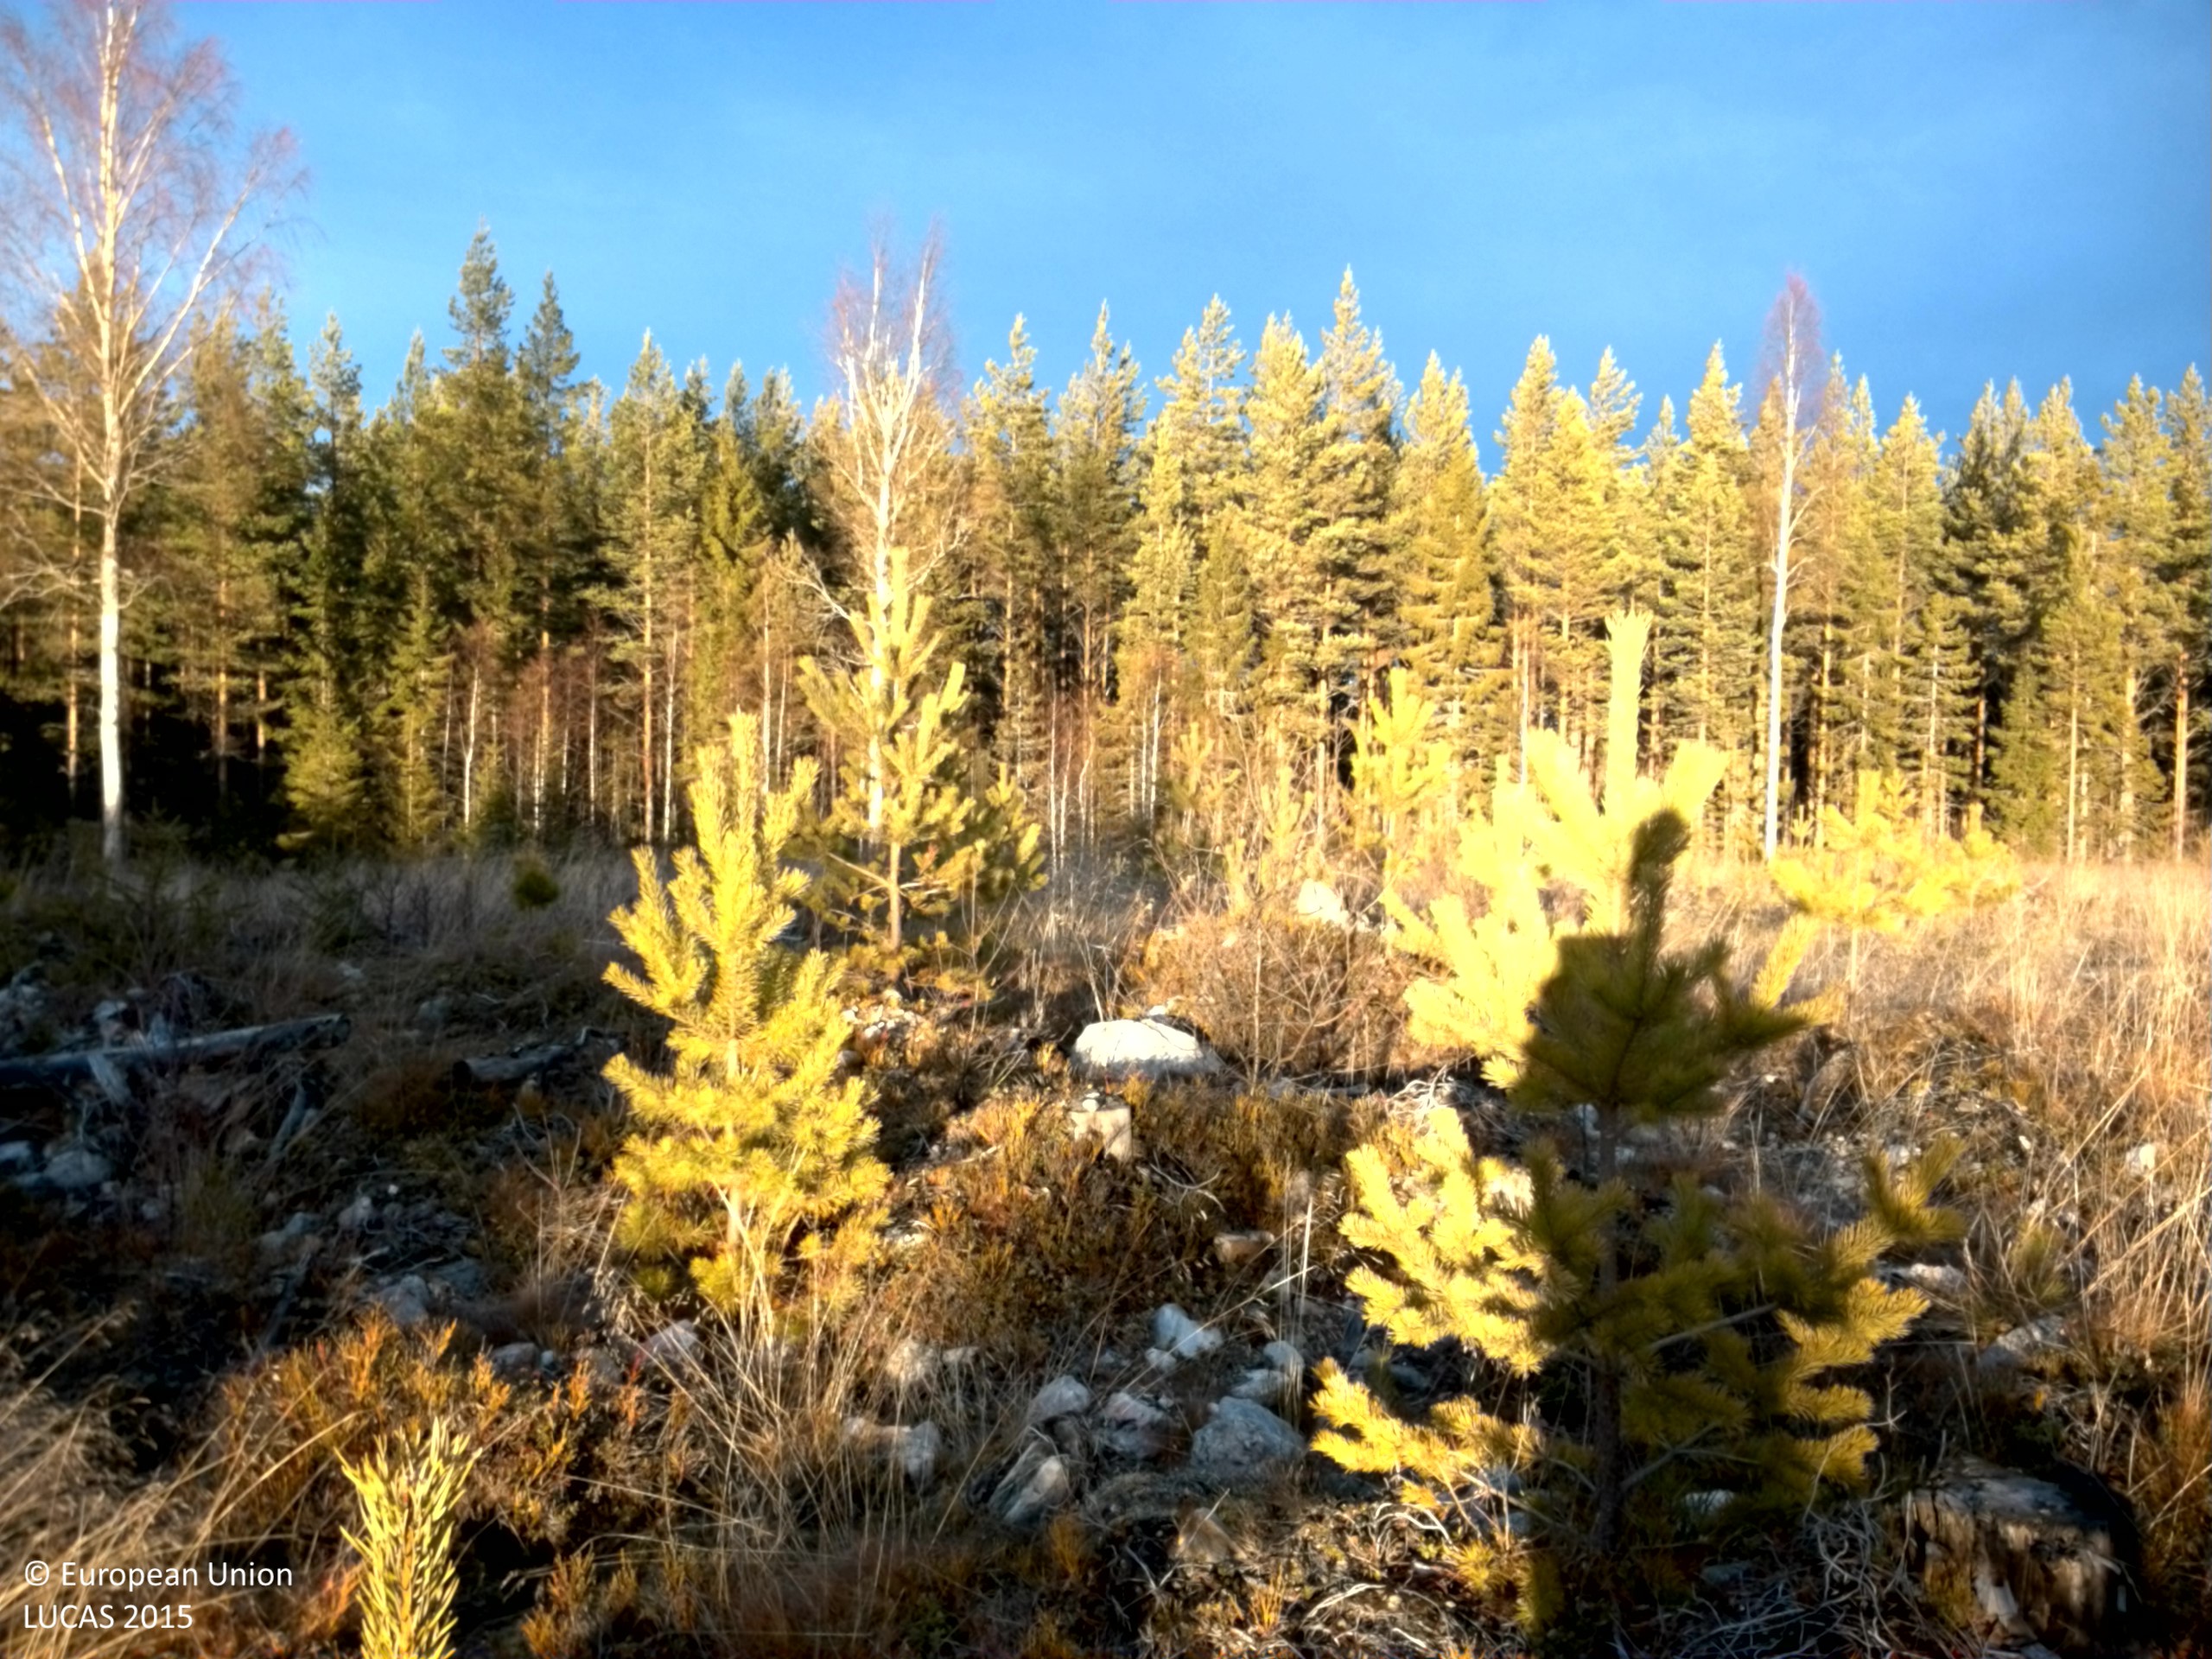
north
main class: Woodland
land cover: Pine dominated mixed woodland
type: boreal forest
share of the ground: 10 - 25 %
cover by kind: shrubs 35 %, herbaceous plants 20 %, coniferous forest trees 15 %, consolidated bare surface 15 %, lichens and mosses 10 %, broadleaved forest trees 5 %
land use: Forestry
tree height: < 5 m
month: December
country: SE
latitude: 61.0249
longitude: 16.8894
